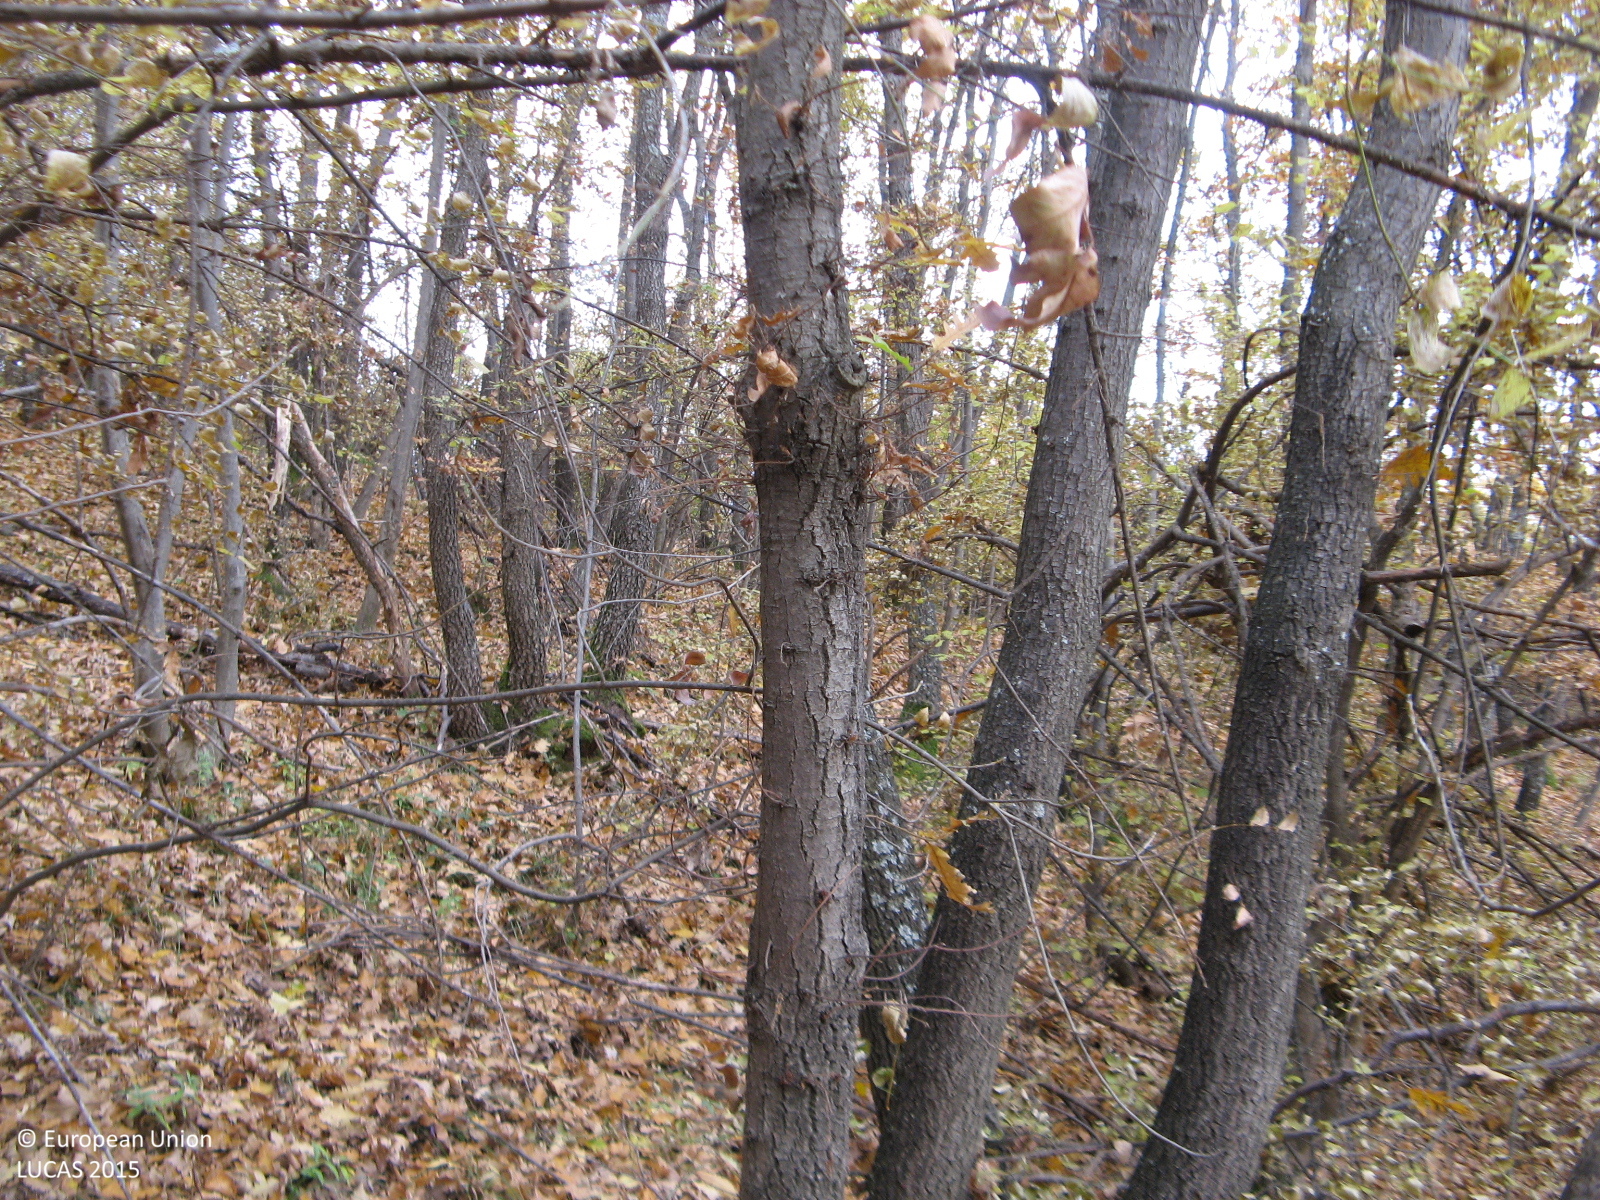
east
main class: Woodland
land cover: Broadleaved woodland
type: mesophytic deciduous forest
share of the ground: > 75 %
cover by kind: broadleaved forest trees 95 %, unconsolidated bare surface 5 %
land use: Forestry
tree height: > 5 m
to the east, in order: Broadleaved woodland; Shrubland with sparse tree cover; Electric lines; Shrubland with sparse tree cover; Broadleaved woodland
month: November
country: BG
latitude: 41.7258
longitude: 25.9745
